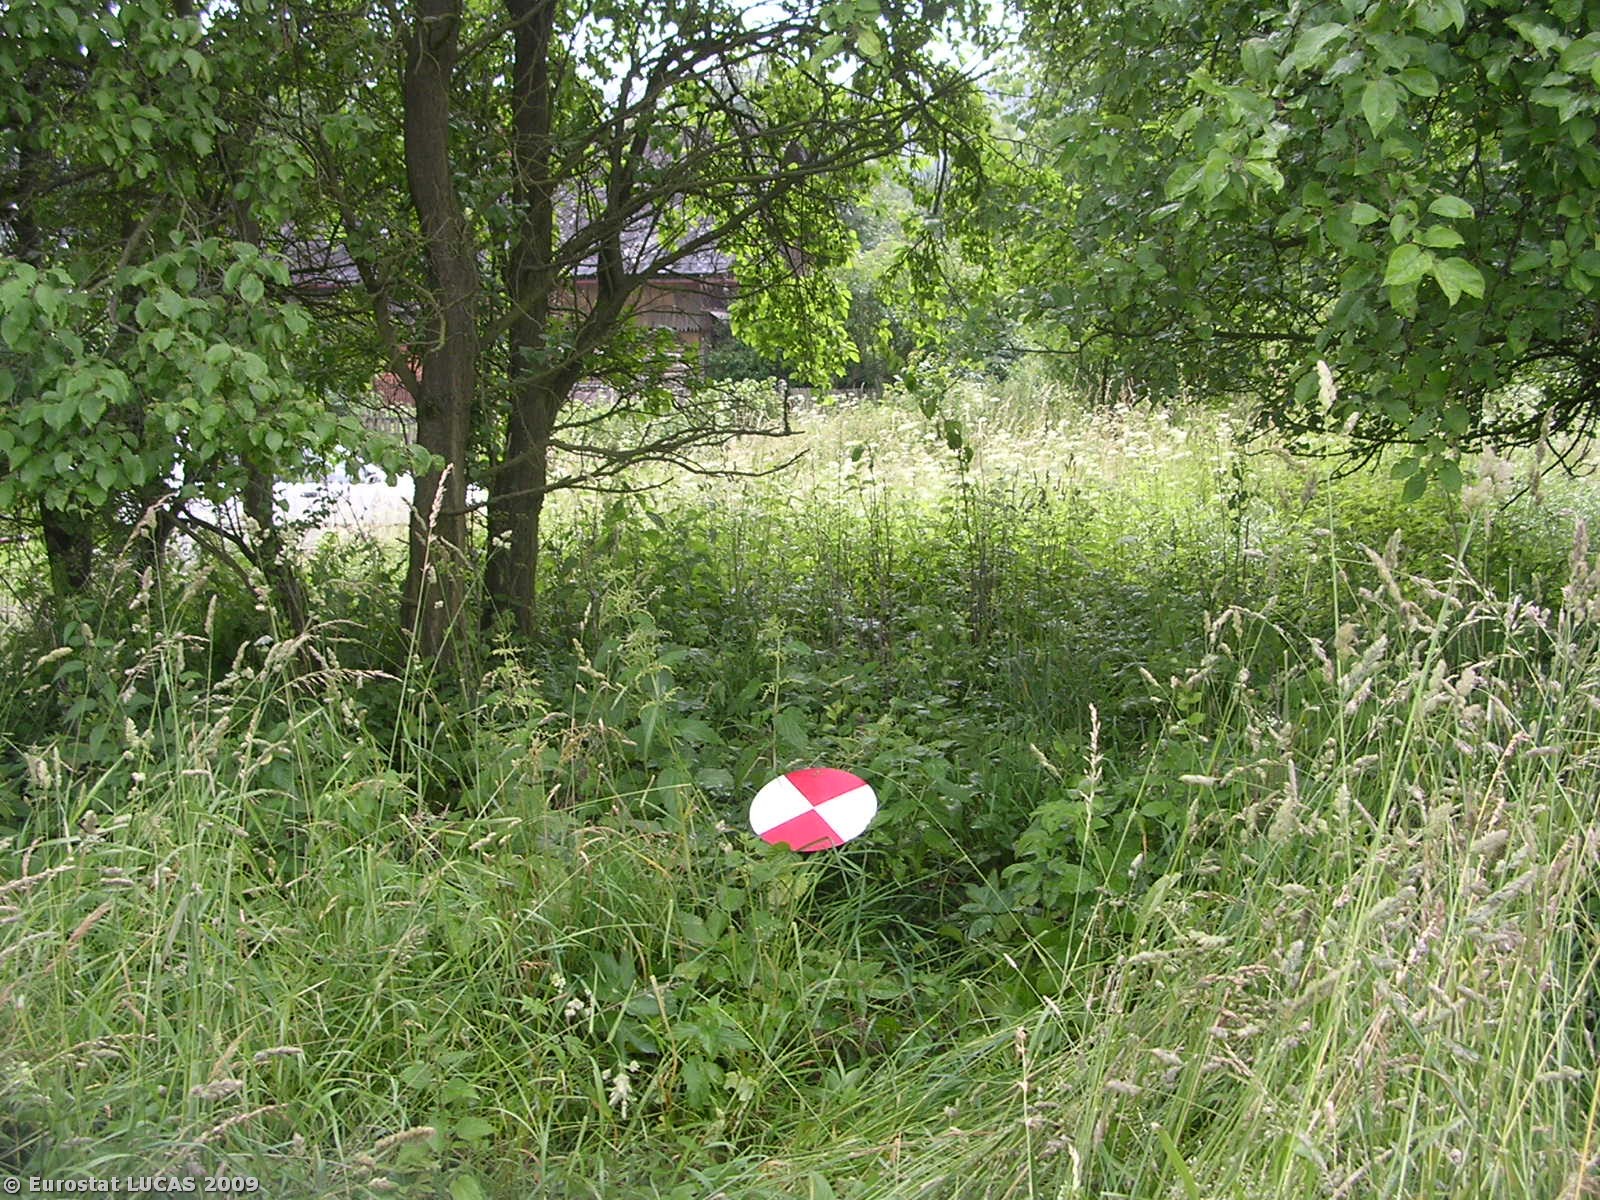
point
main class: Cropland
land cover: Other fruit trees and berries
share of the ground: 25 - 50 %
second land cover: Grassland with sparse tree/shrub cover
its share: > 75 %
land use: Kitchen garden
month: July
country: CZ
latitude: 50.6488
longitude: 15.0520
